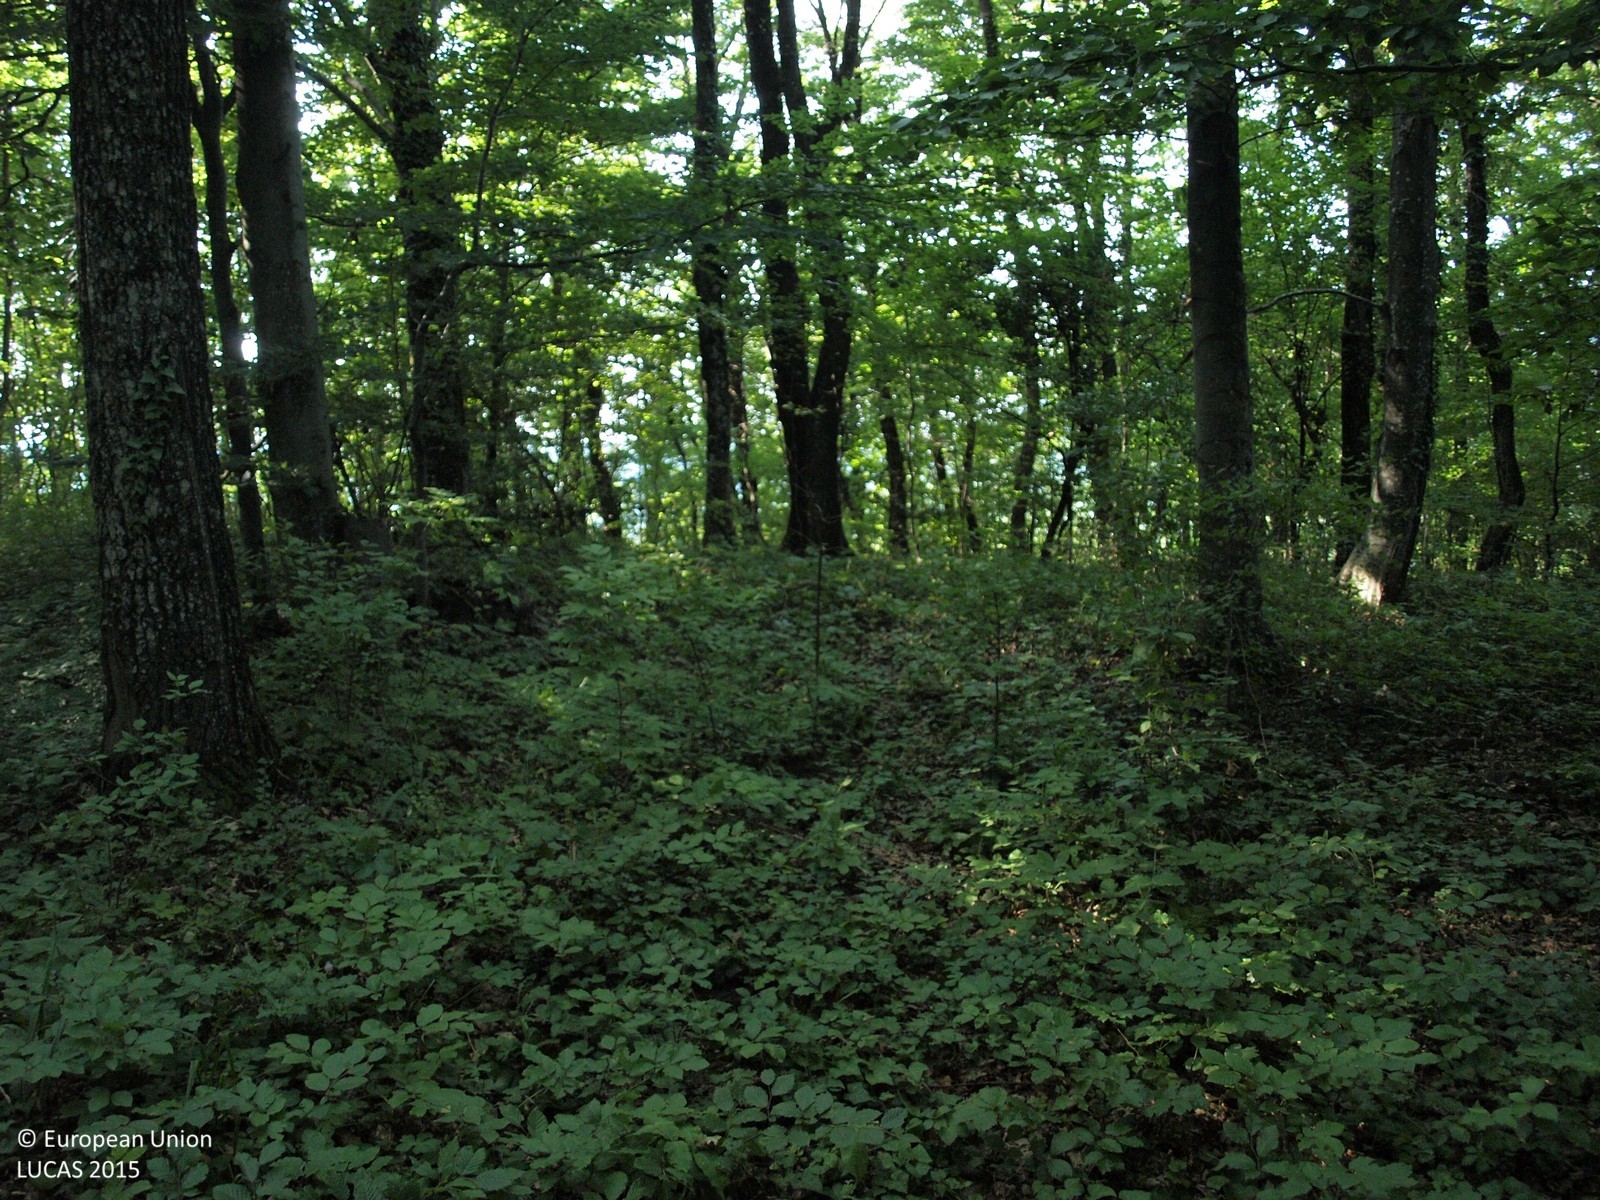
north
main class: Woodland
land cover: Broadleaved woodland
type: mesophytic deciduous forest
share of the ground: > 75 %
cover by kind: broadleaved forest trees 100 %
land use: Forestry
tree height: > 5 m
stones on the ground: < 10 %
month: July
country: HR
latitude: 46.1650
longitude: 15.9952
